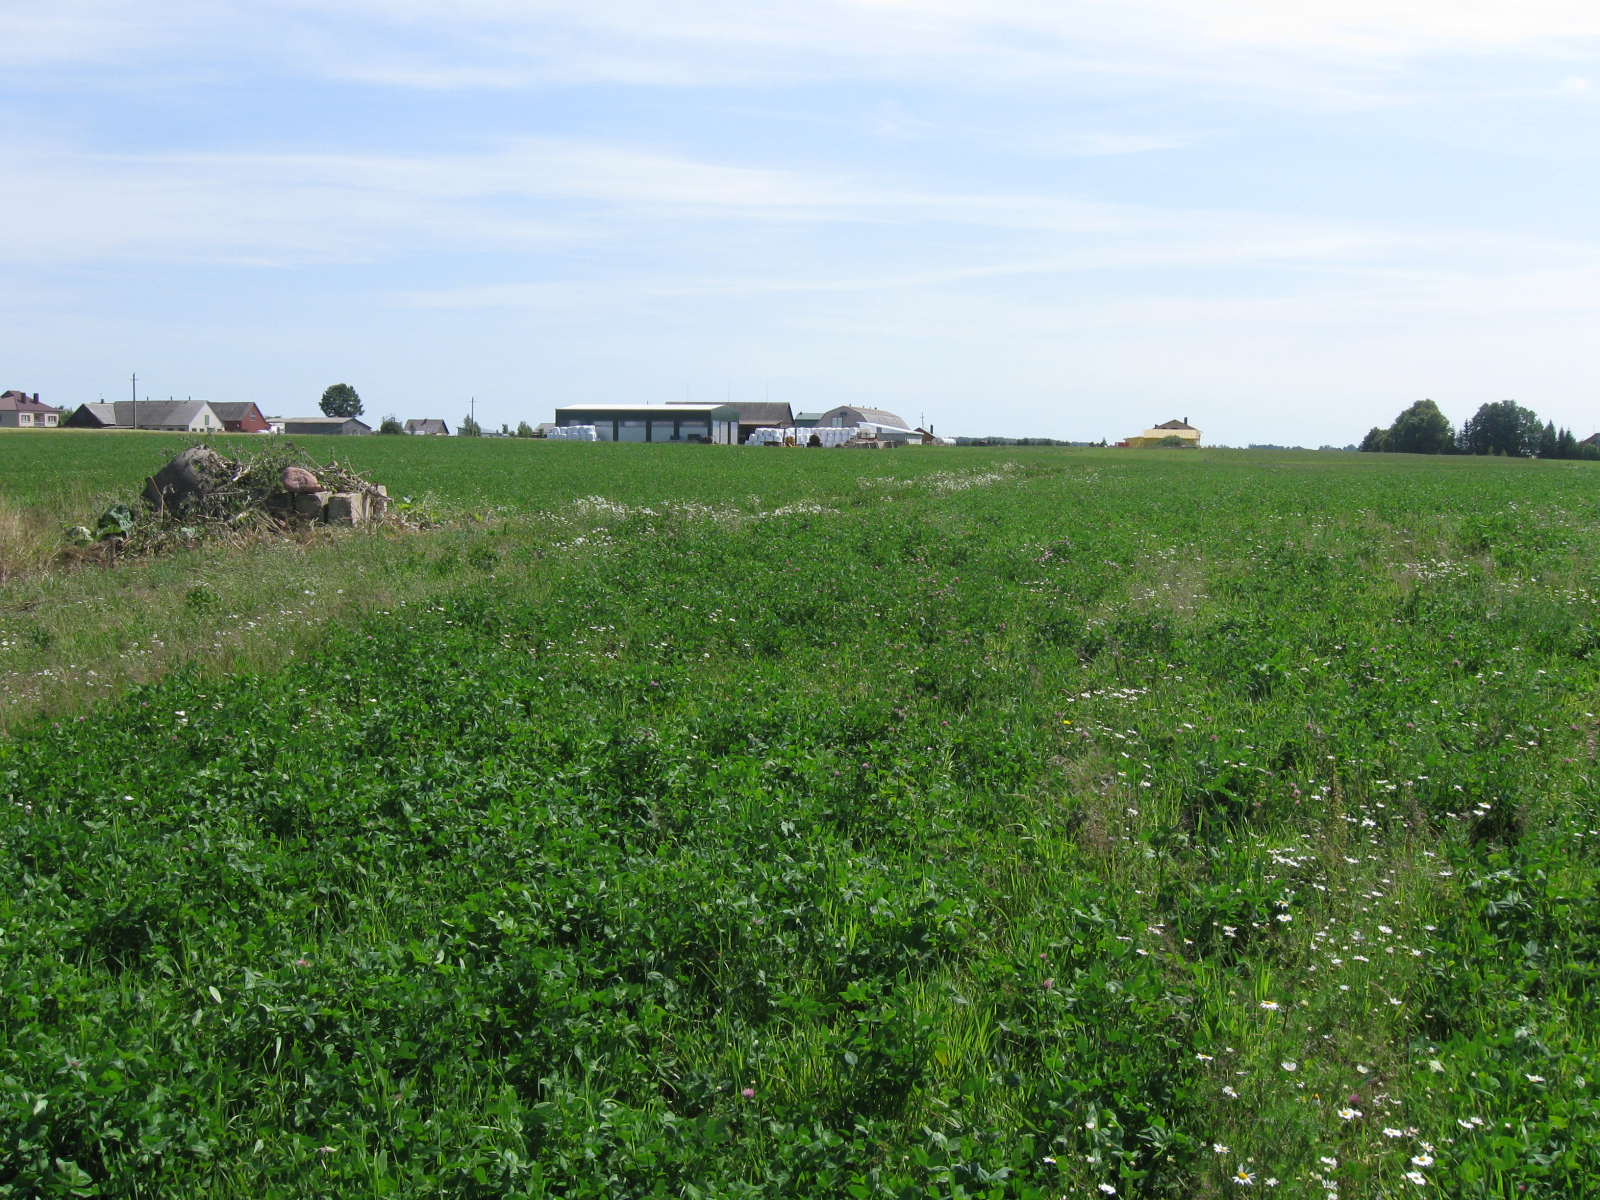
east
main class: Cropland
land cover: Clovers
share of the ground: > 75 %
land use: Agriculture (excluding fallow land and kitchen gardens)
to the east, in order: Clovers; Tracks; Clovers; Tracks; Clovers; Tracks; Clovers; Grassland without tree/shrub cover
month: July
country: LT
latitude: 54.7148
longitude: 23.8891
